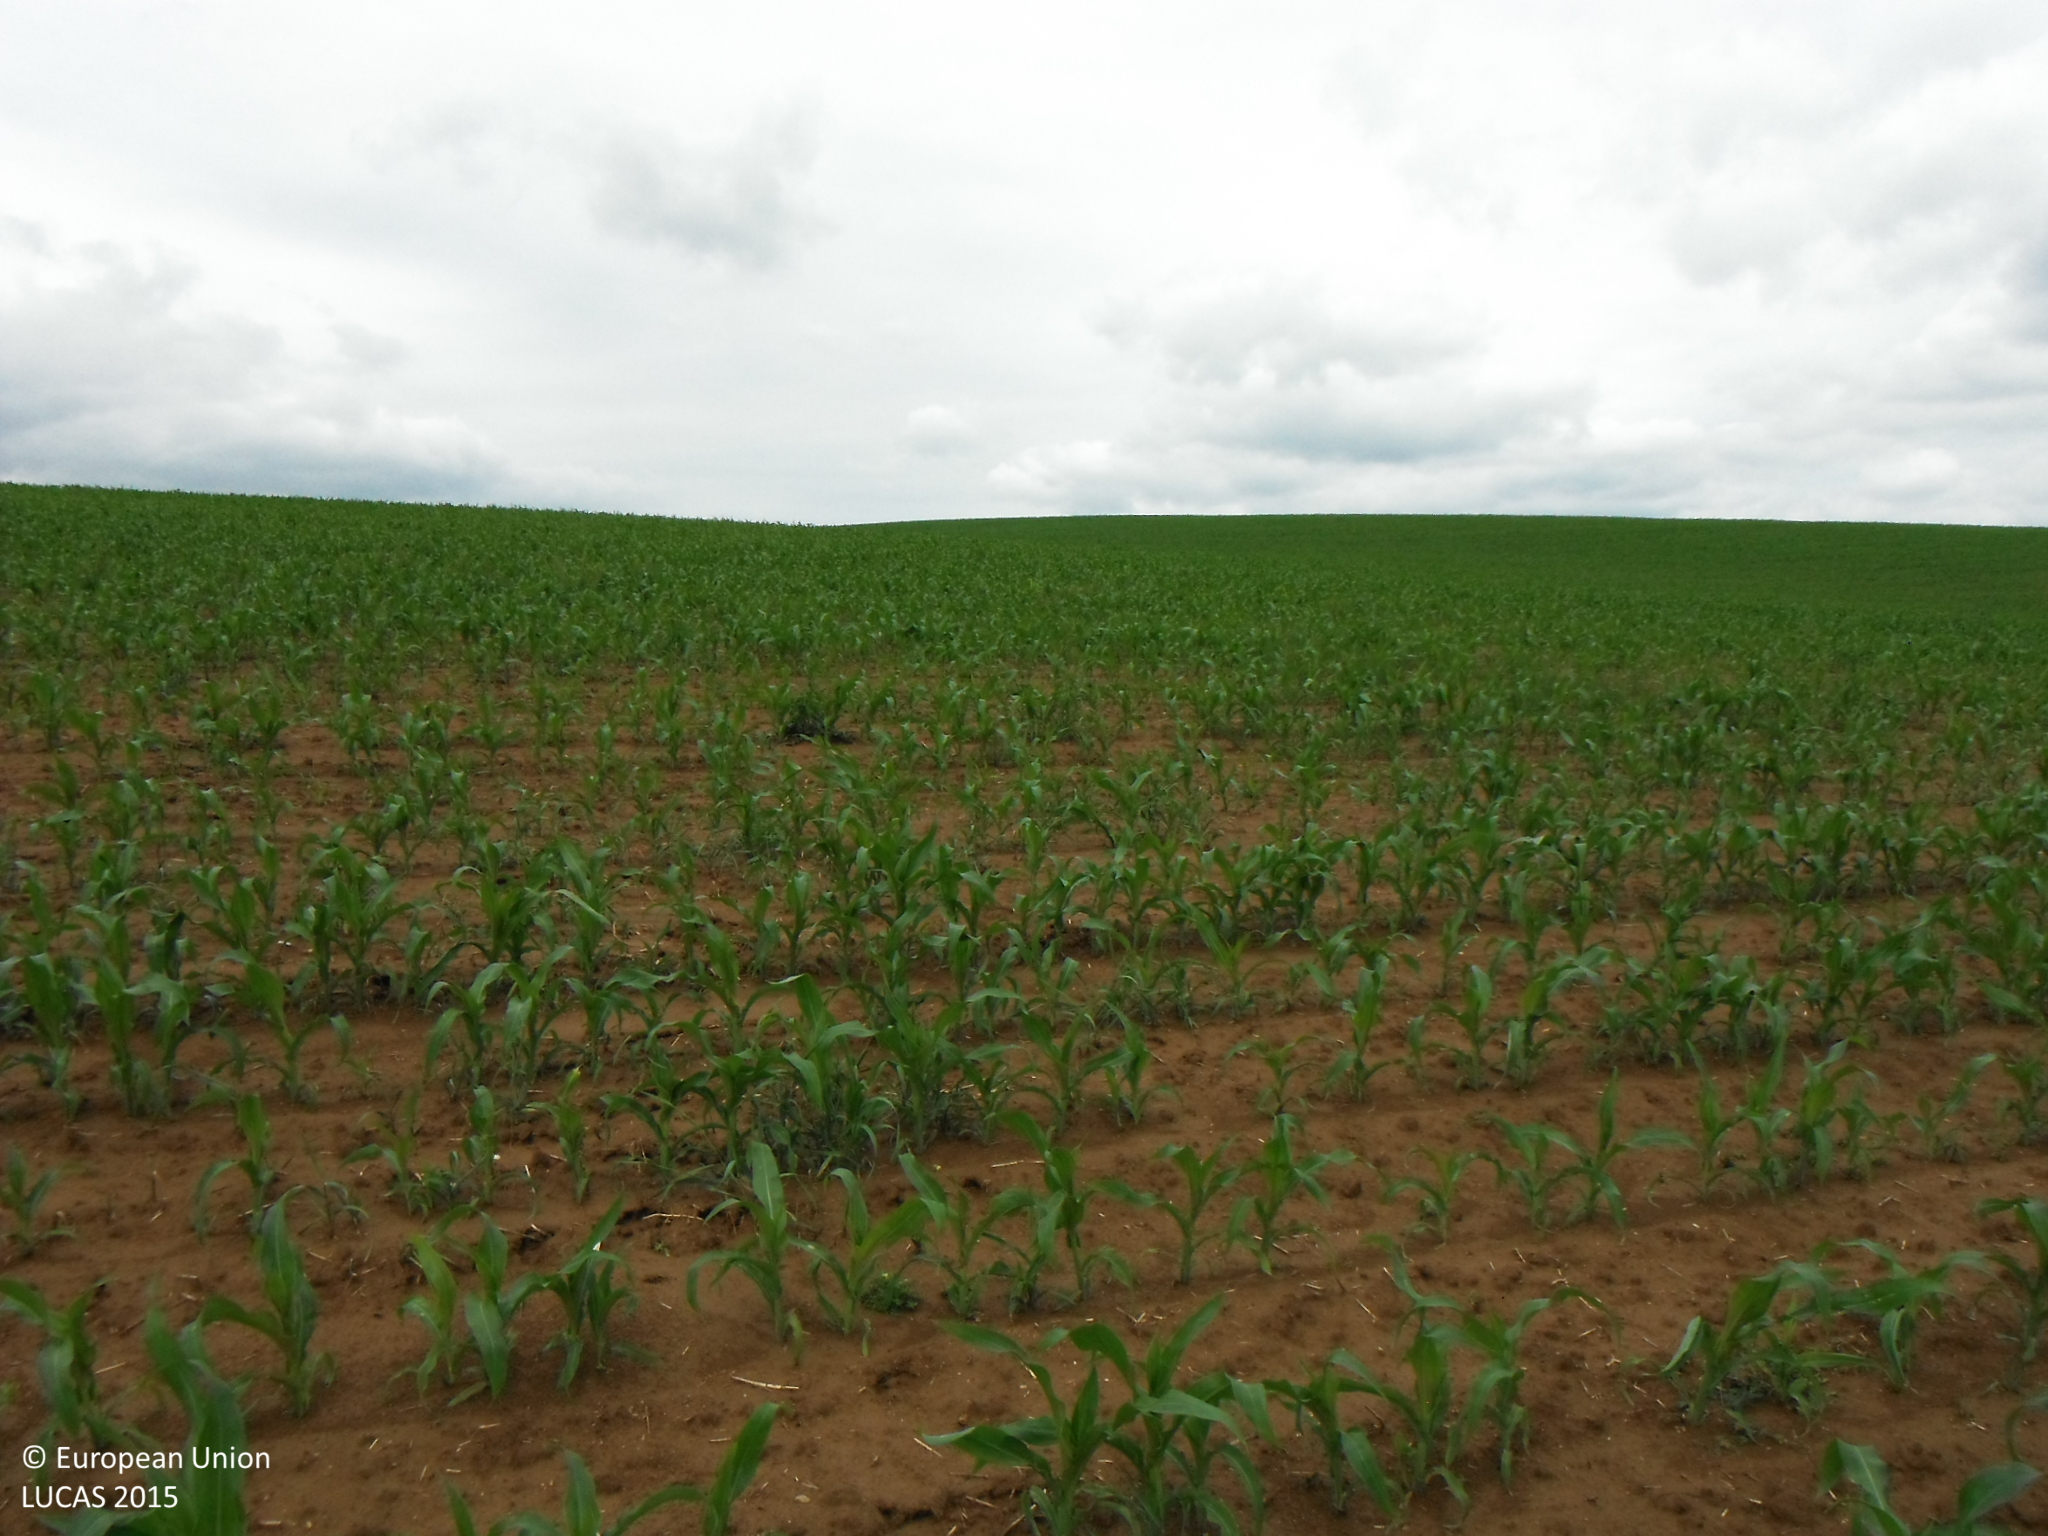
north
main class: Cropland
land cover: Maize
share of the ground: 25 - 50 %
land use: Agriculture (excluding fallow land and kitchen gardens)
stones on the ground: < 10 %
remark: Temporary flooded
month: June
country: SK
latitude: 49.0483
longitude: 21.3895
